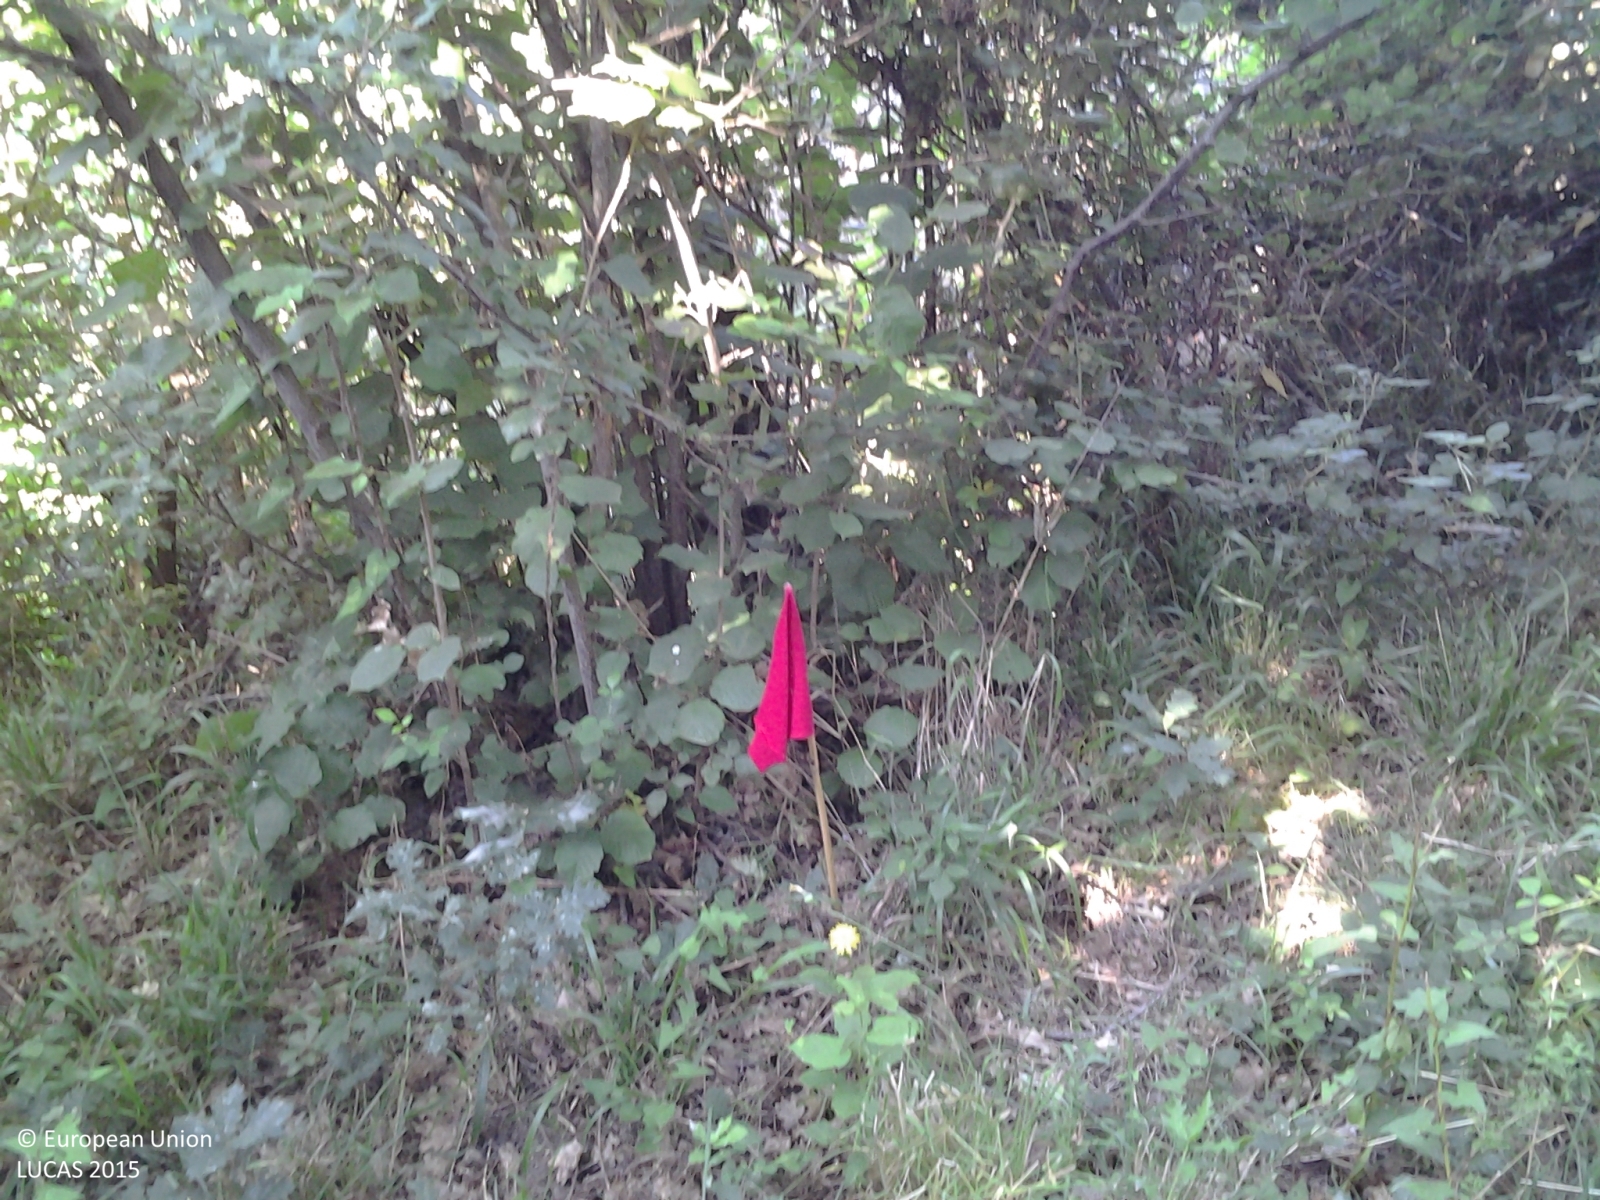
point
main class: Cropland
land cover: Nuts trees
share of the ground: > 75 %
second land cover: Spontaneously vegetated surfaces
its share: > 75 %
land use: Agriculture (excluding fallow land and kitchen gardens)
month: July
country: IT
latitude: 38.0936
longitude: 14.9049
